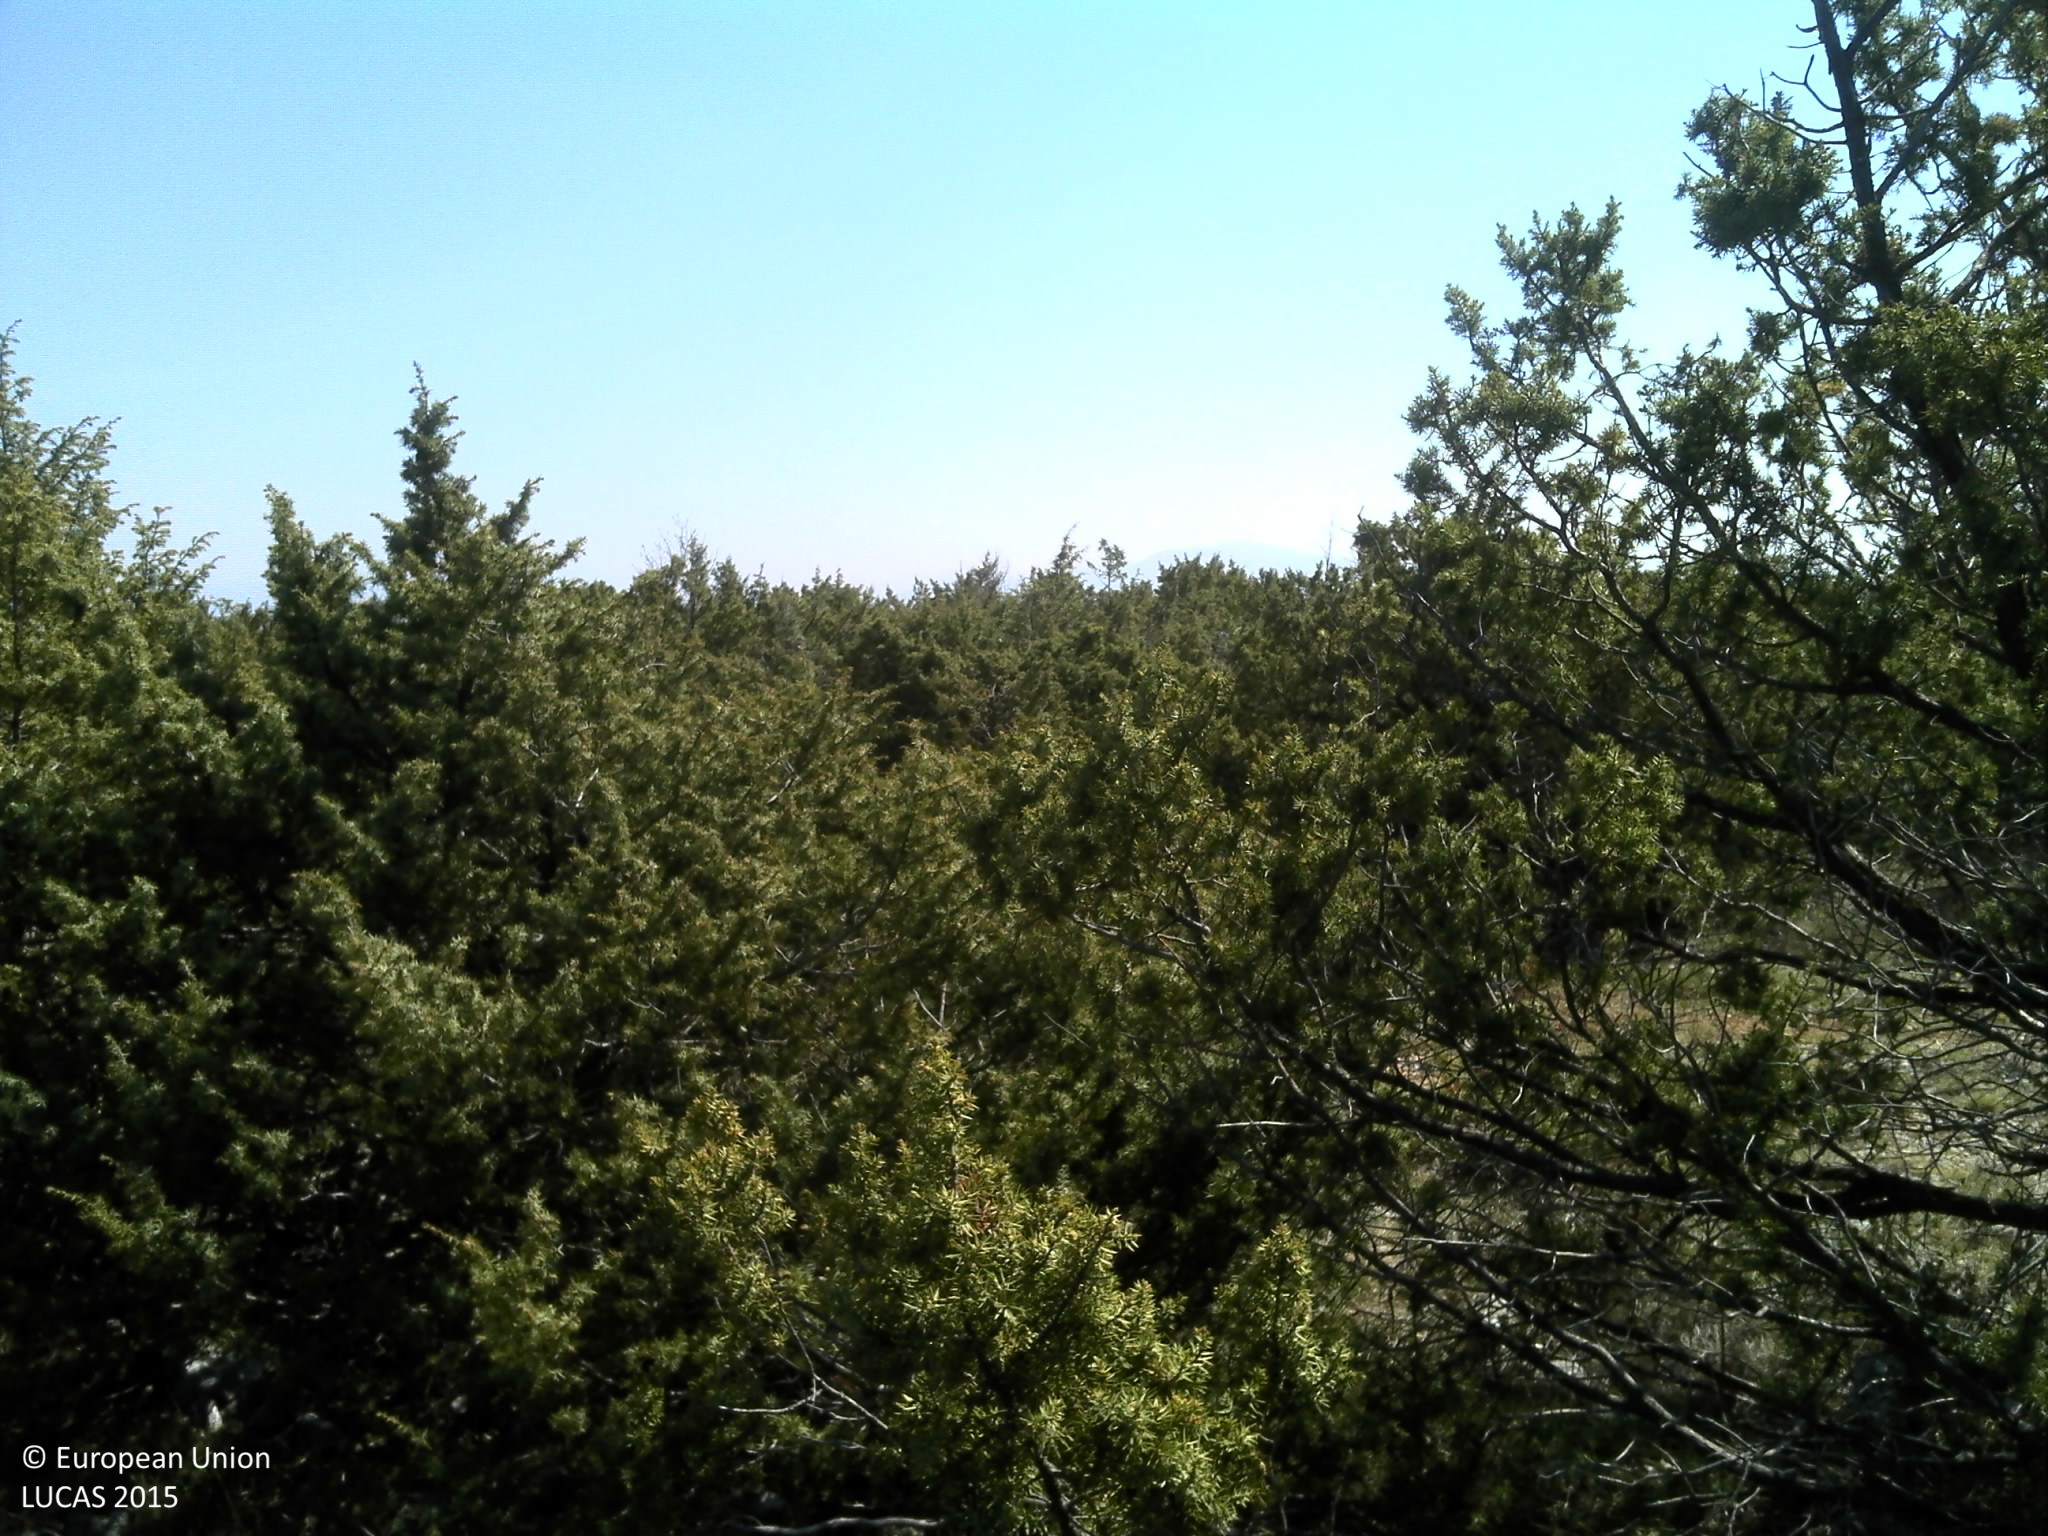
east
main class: Shrubland
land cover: Shrubland with sparse tree cover
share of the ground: > 75 %
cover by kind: shrubs 70 %, unconsolidated bare surface 10 %, broadleaved forest trees 5 %, consolidated bare surface 5 %
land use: Semi-natural and natural areas not in use
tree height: < 5 m
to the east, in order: Shrubland with sparse tree cover; Tracks; Shrubland with sparse tree cover; Dry stone walls; Shrubland with sparse tree cover; Dry stone walls; Shrubland with sparse tree cover; Dry stone walls; Shrubland with sparse tree cover; Grassland without tree/shrub cover; Abandoned hedges; Railways; Grassland without tree/shrub cover
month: April
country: HR
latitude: 43.9513
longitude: 15.8358
